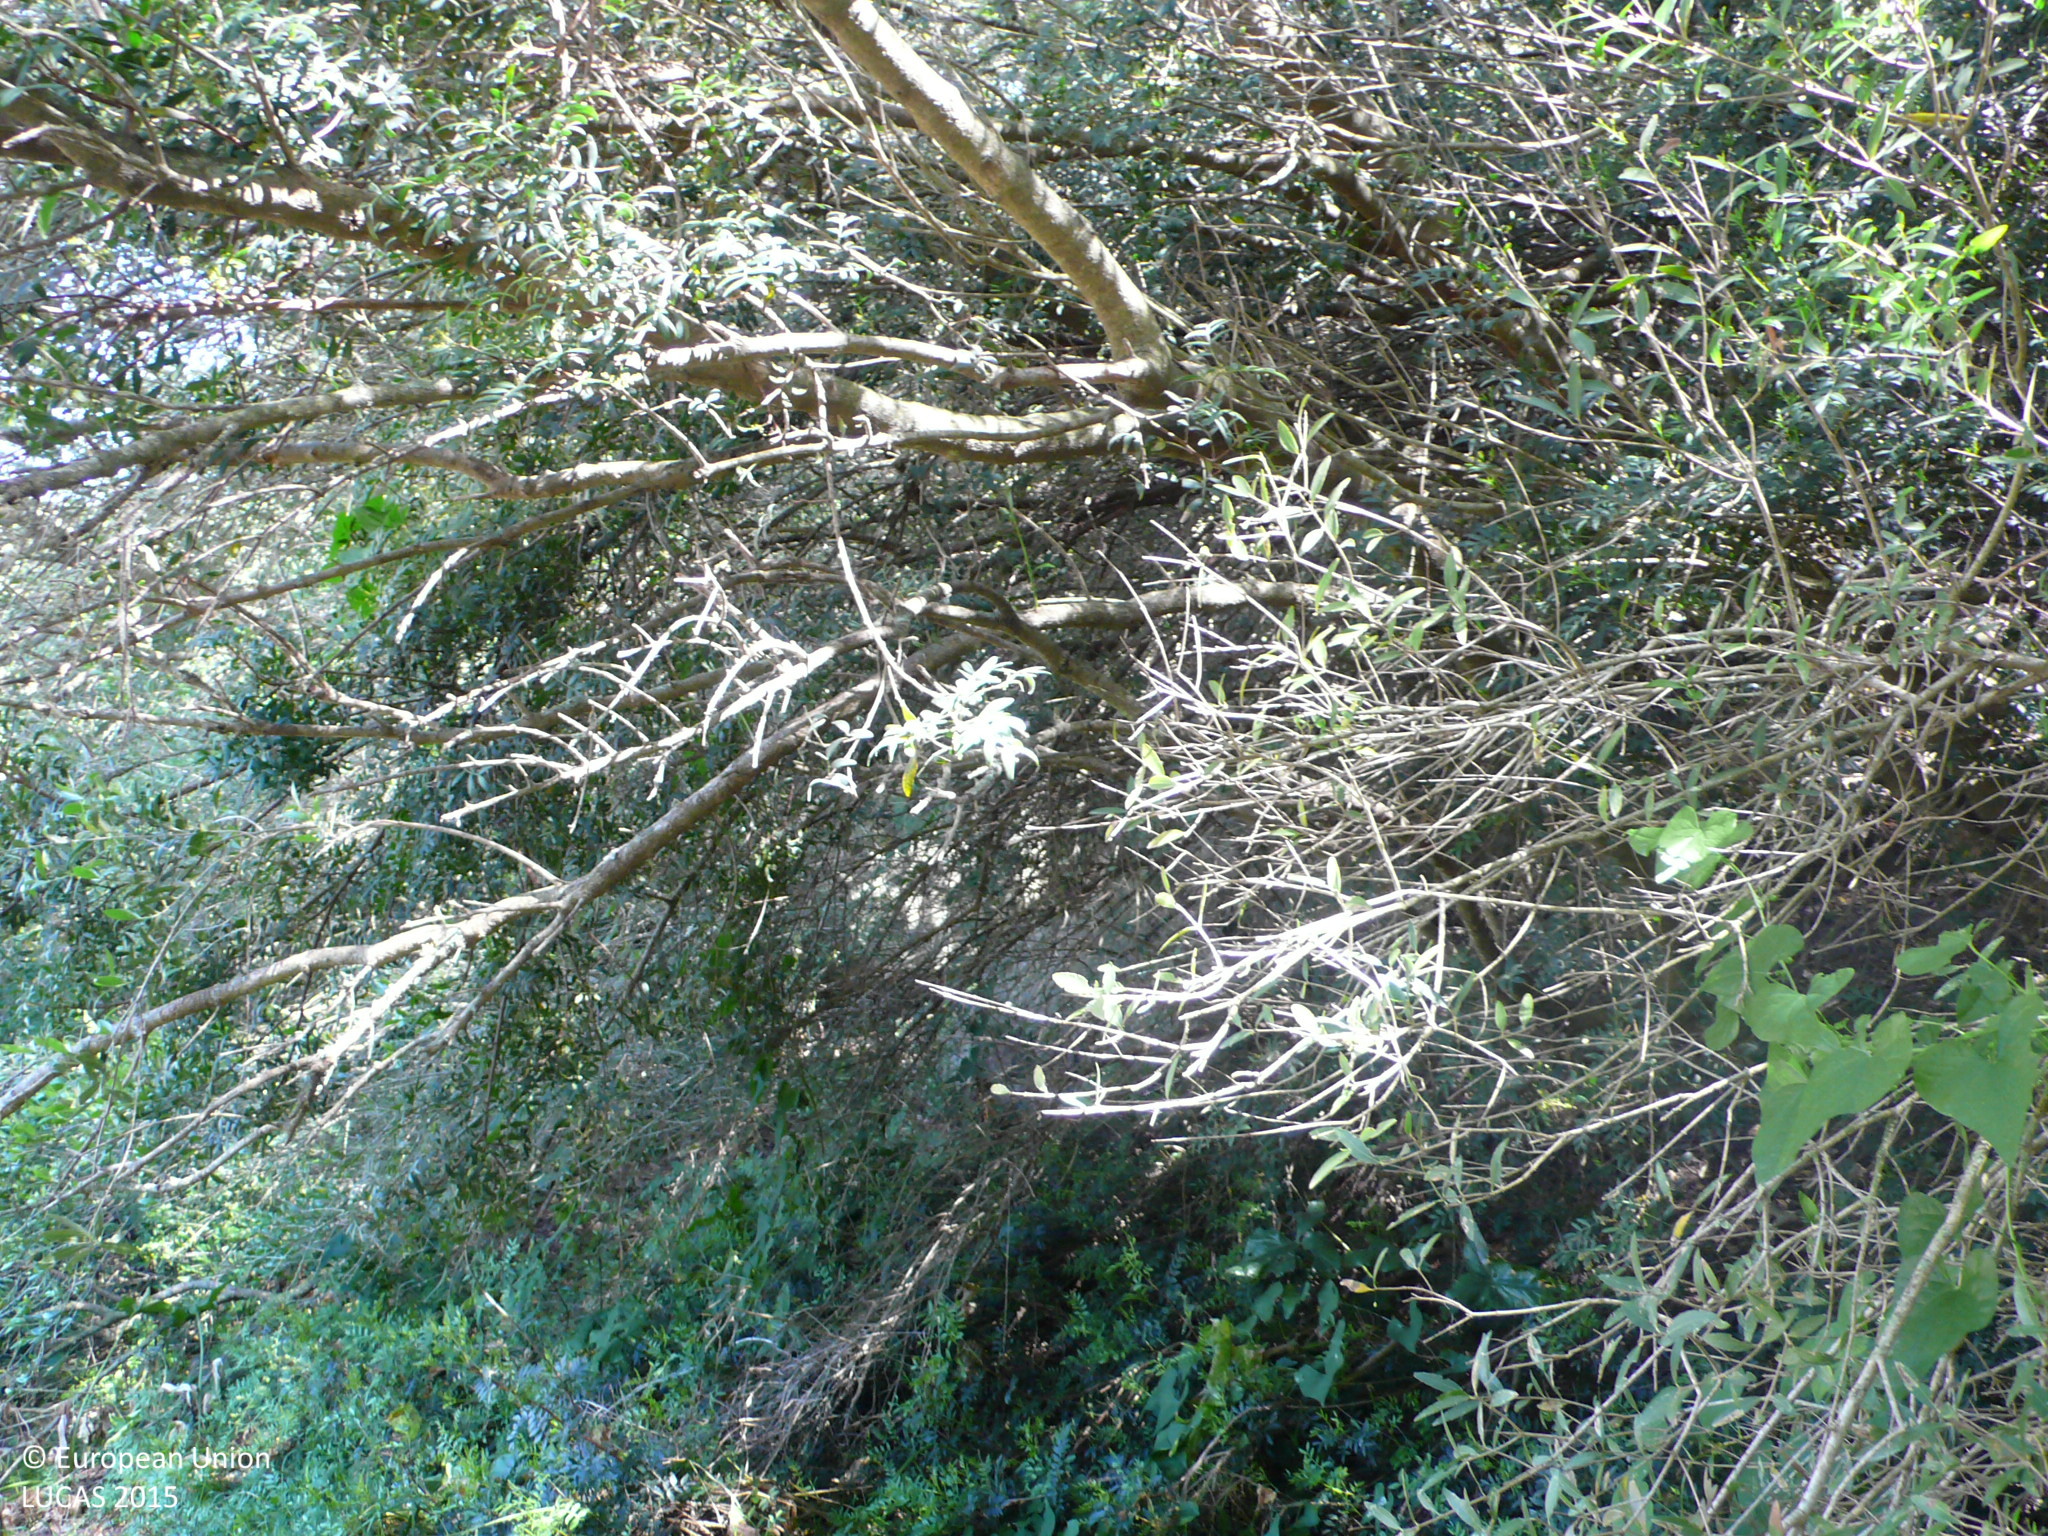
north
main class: Woodland
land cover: Broadleaved woodland
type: broadleaved evergreen forest
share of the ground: > 75 %
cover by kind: broadleaved forest trees 90 %, shrubs 10 %
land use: Semi-natural and natural areas not in use
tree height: > 5 m
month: May
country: ES
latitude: 39.9635
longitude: 4.1140
